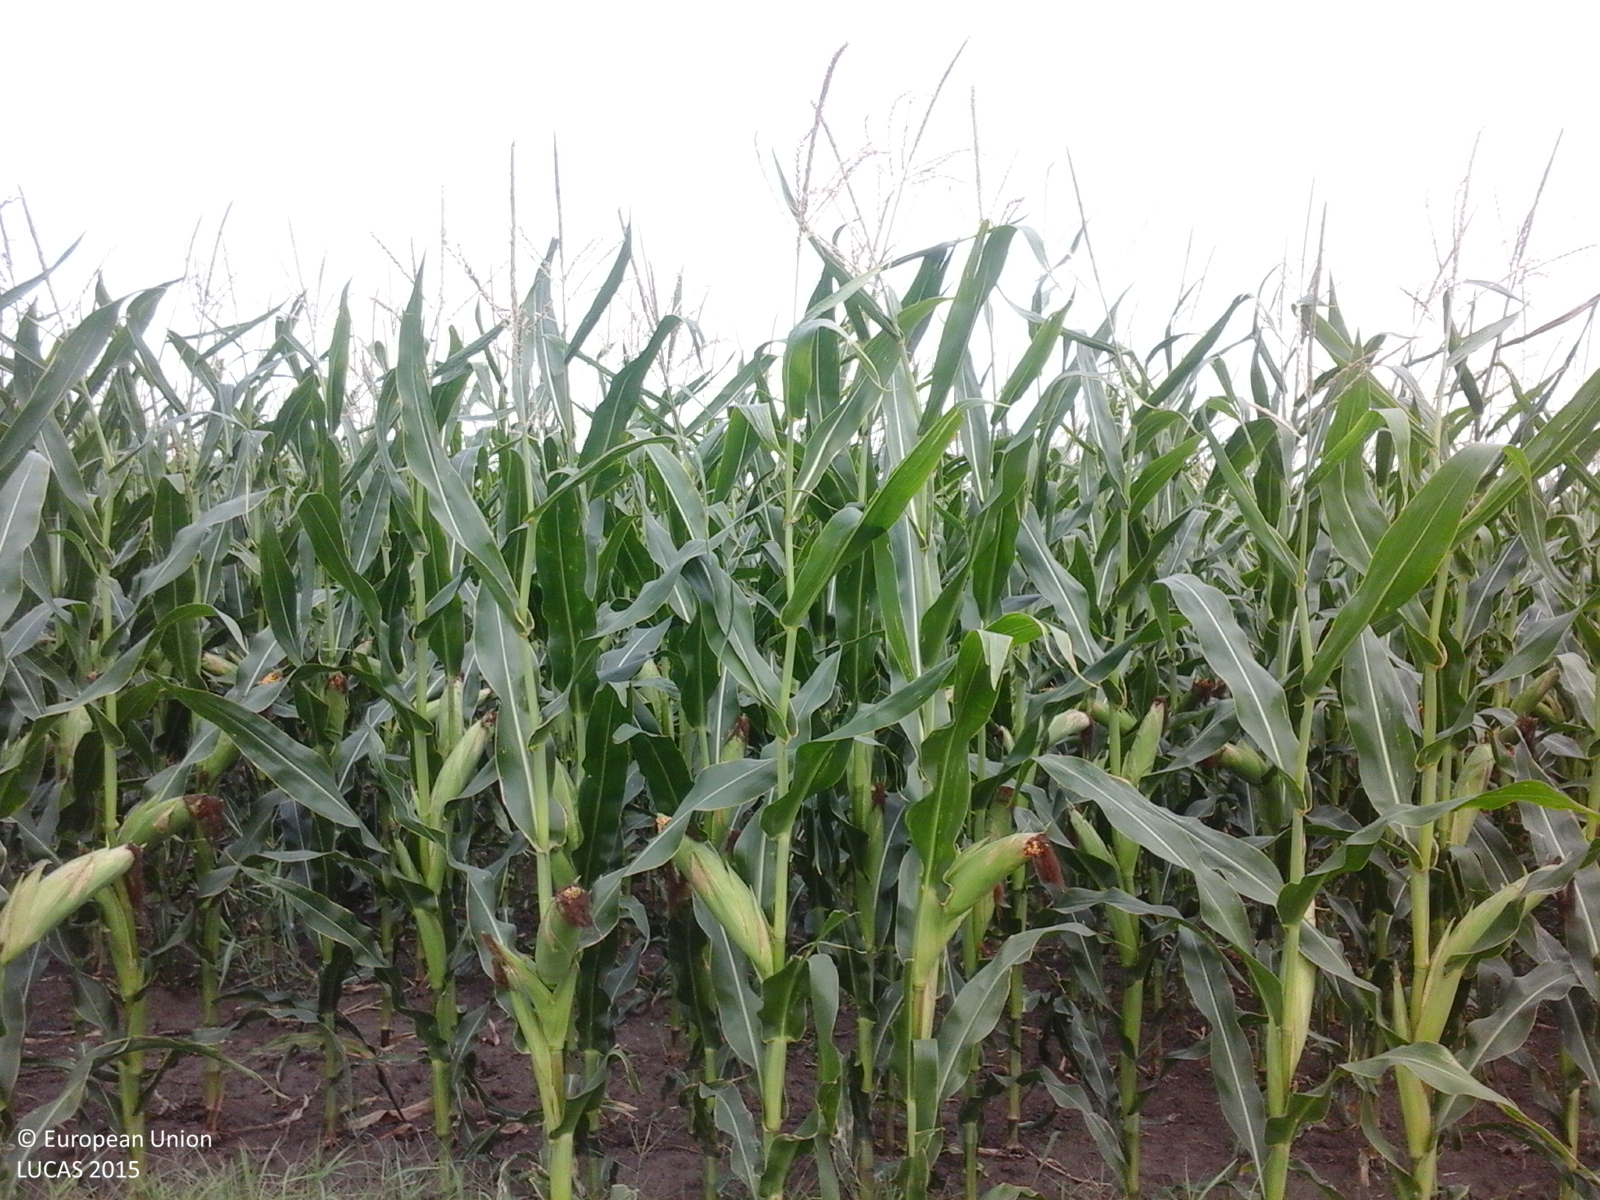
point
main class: Cropland
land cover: Maize
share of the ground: > 75 %
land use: Agriculture (excluding fallow land and kitchen gardens)
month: August
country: RO
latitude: 45.0588
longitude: 27.6133
